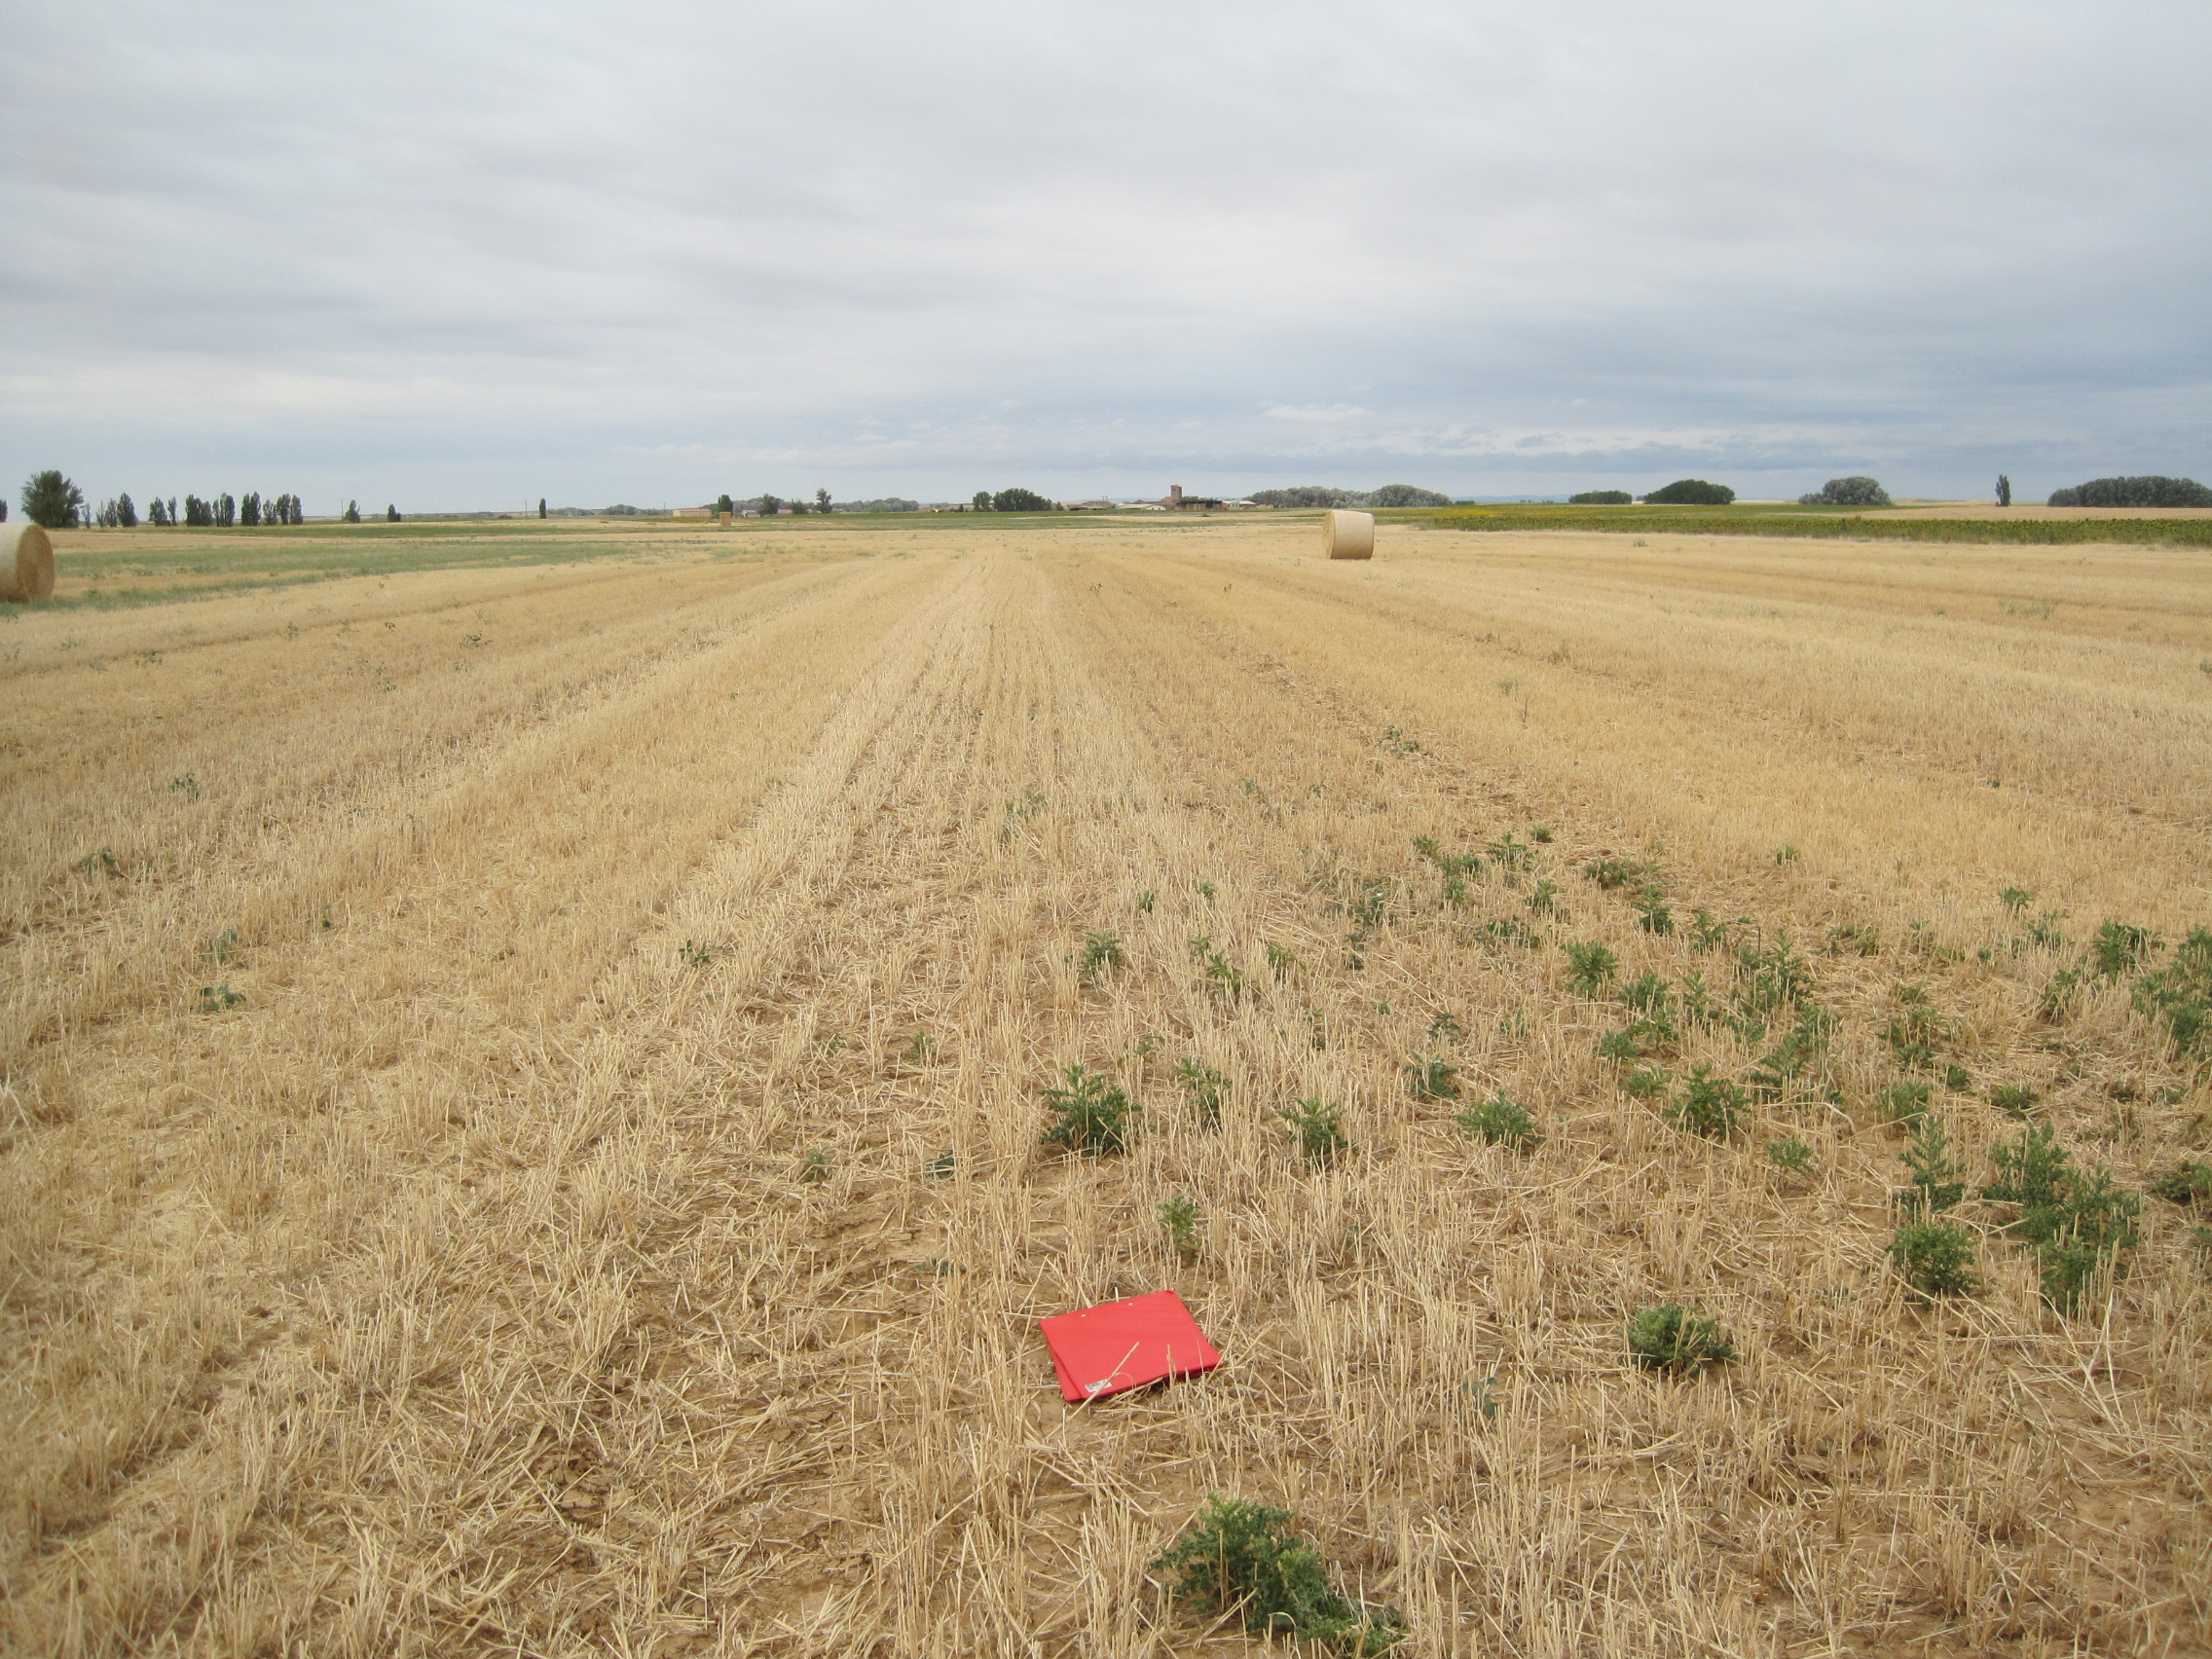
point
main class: Cropland
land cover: Barley
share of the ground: < 10 %
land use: Agriculture (excluding fallow land and kitchen gardens)
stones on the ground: < 10 %
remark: Harvested field
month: July
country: ES
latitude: 41.9956
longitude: -5.4301
